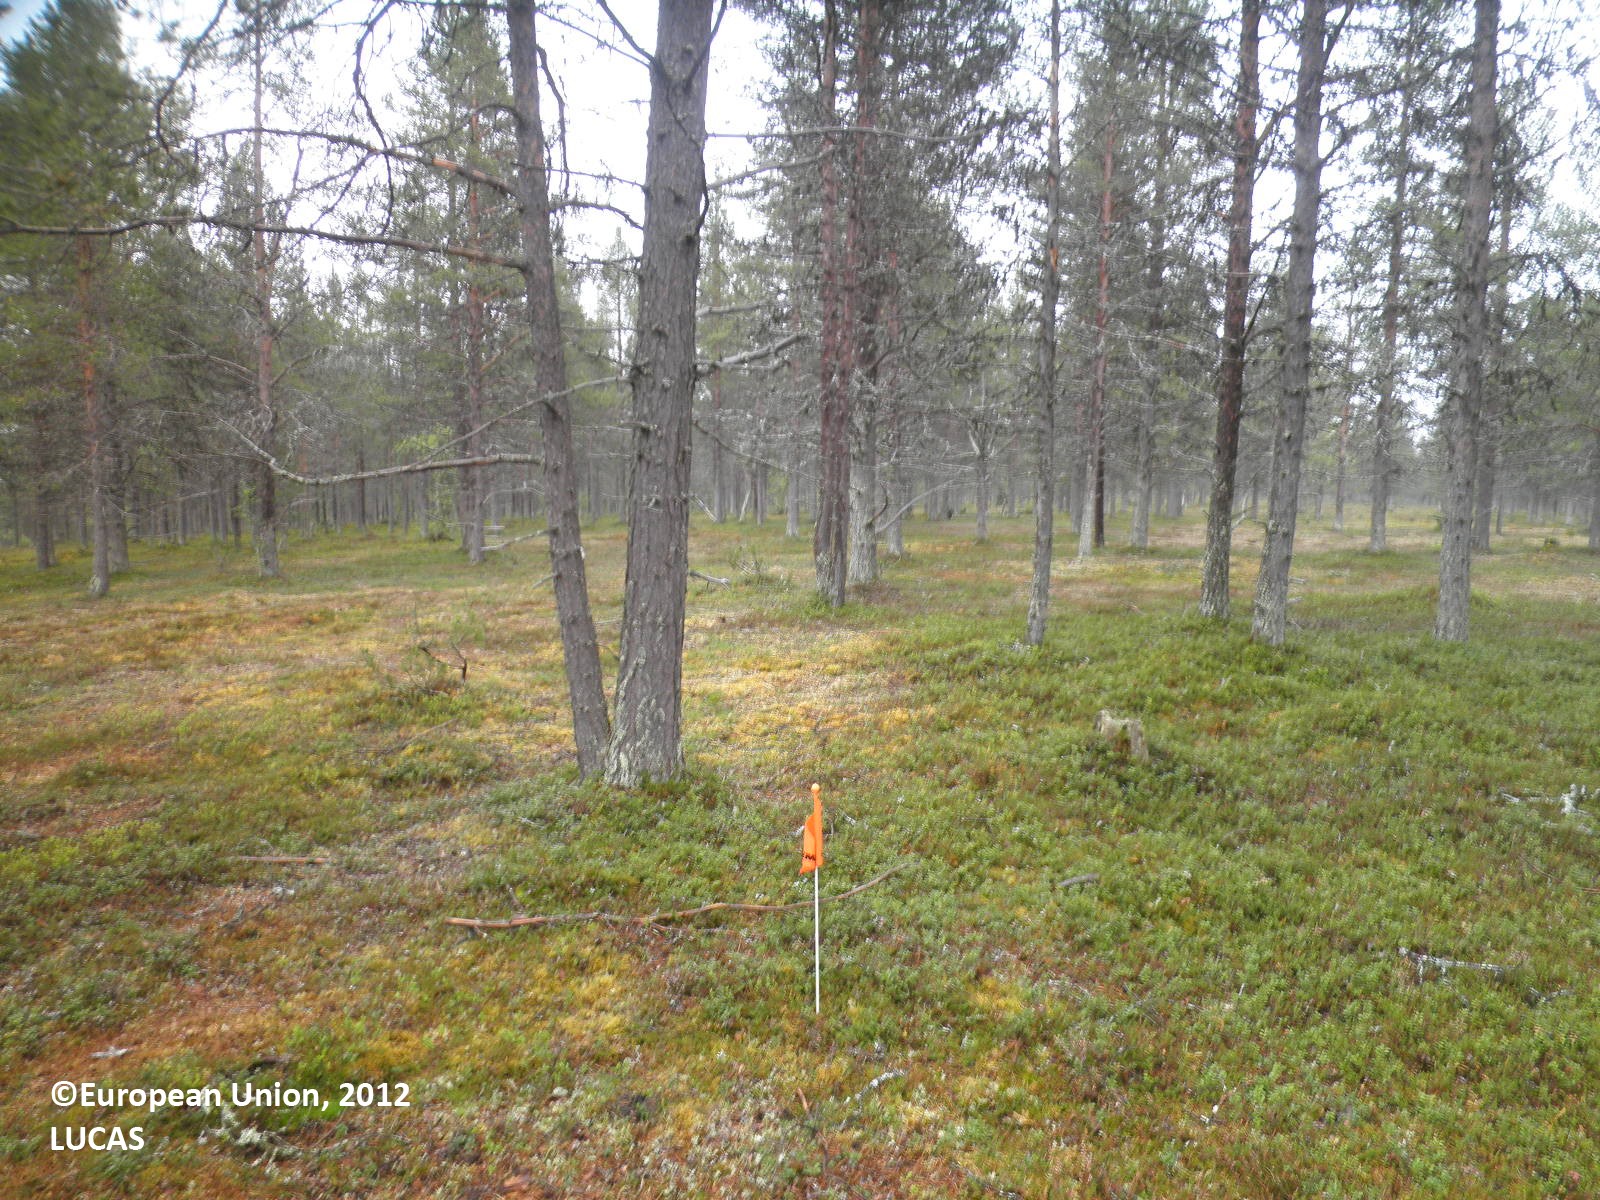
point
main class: Woodland
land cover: Pine dominated coniferous woodland
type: boreal forest
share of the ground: 25 - 50 %
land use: Forestry
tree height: > 5 m
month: June
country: FI
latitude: 68.1649
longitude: 25.7765
